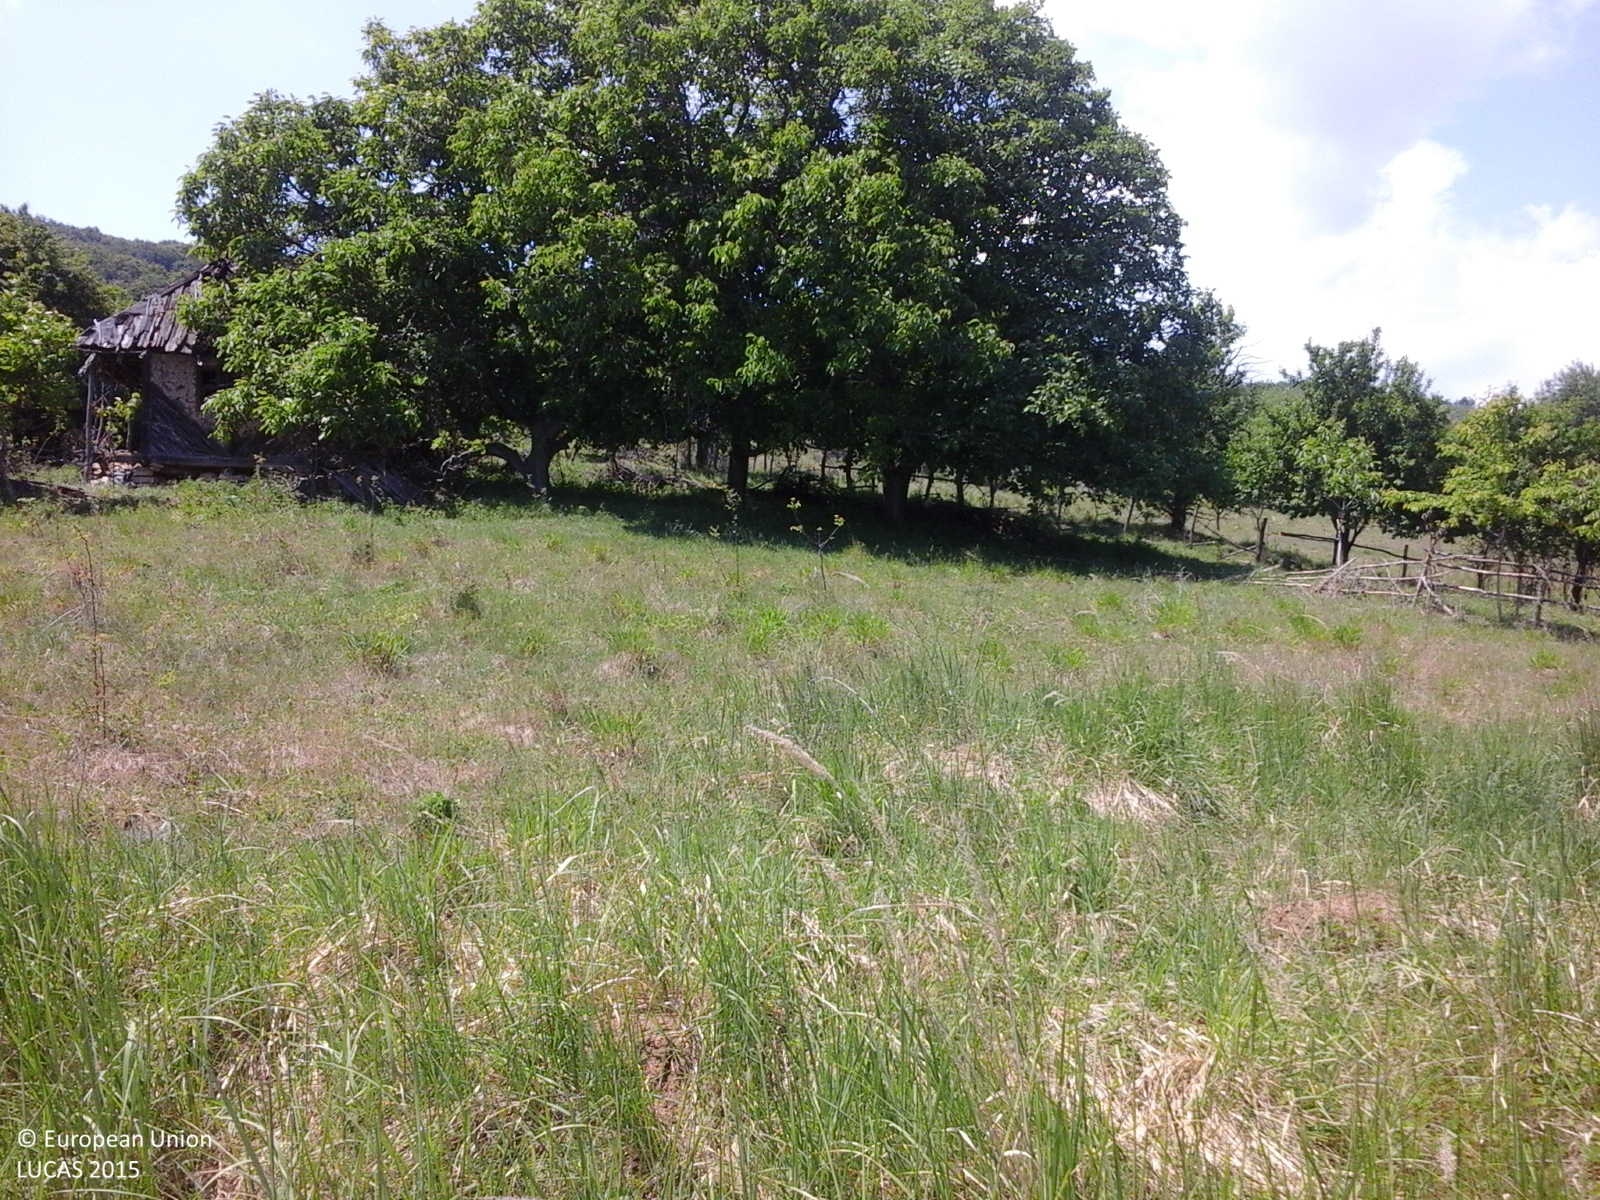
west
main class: Grassland
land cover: Grassland without tree/shrub cover
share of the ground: > 75 %
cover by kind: herbaceous plants 95 %, shrubs 5 %
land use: Agriculture (excluding fallow land and kitchen gardens)
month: June
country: RO
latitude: 46.3459
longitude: 26.8389
